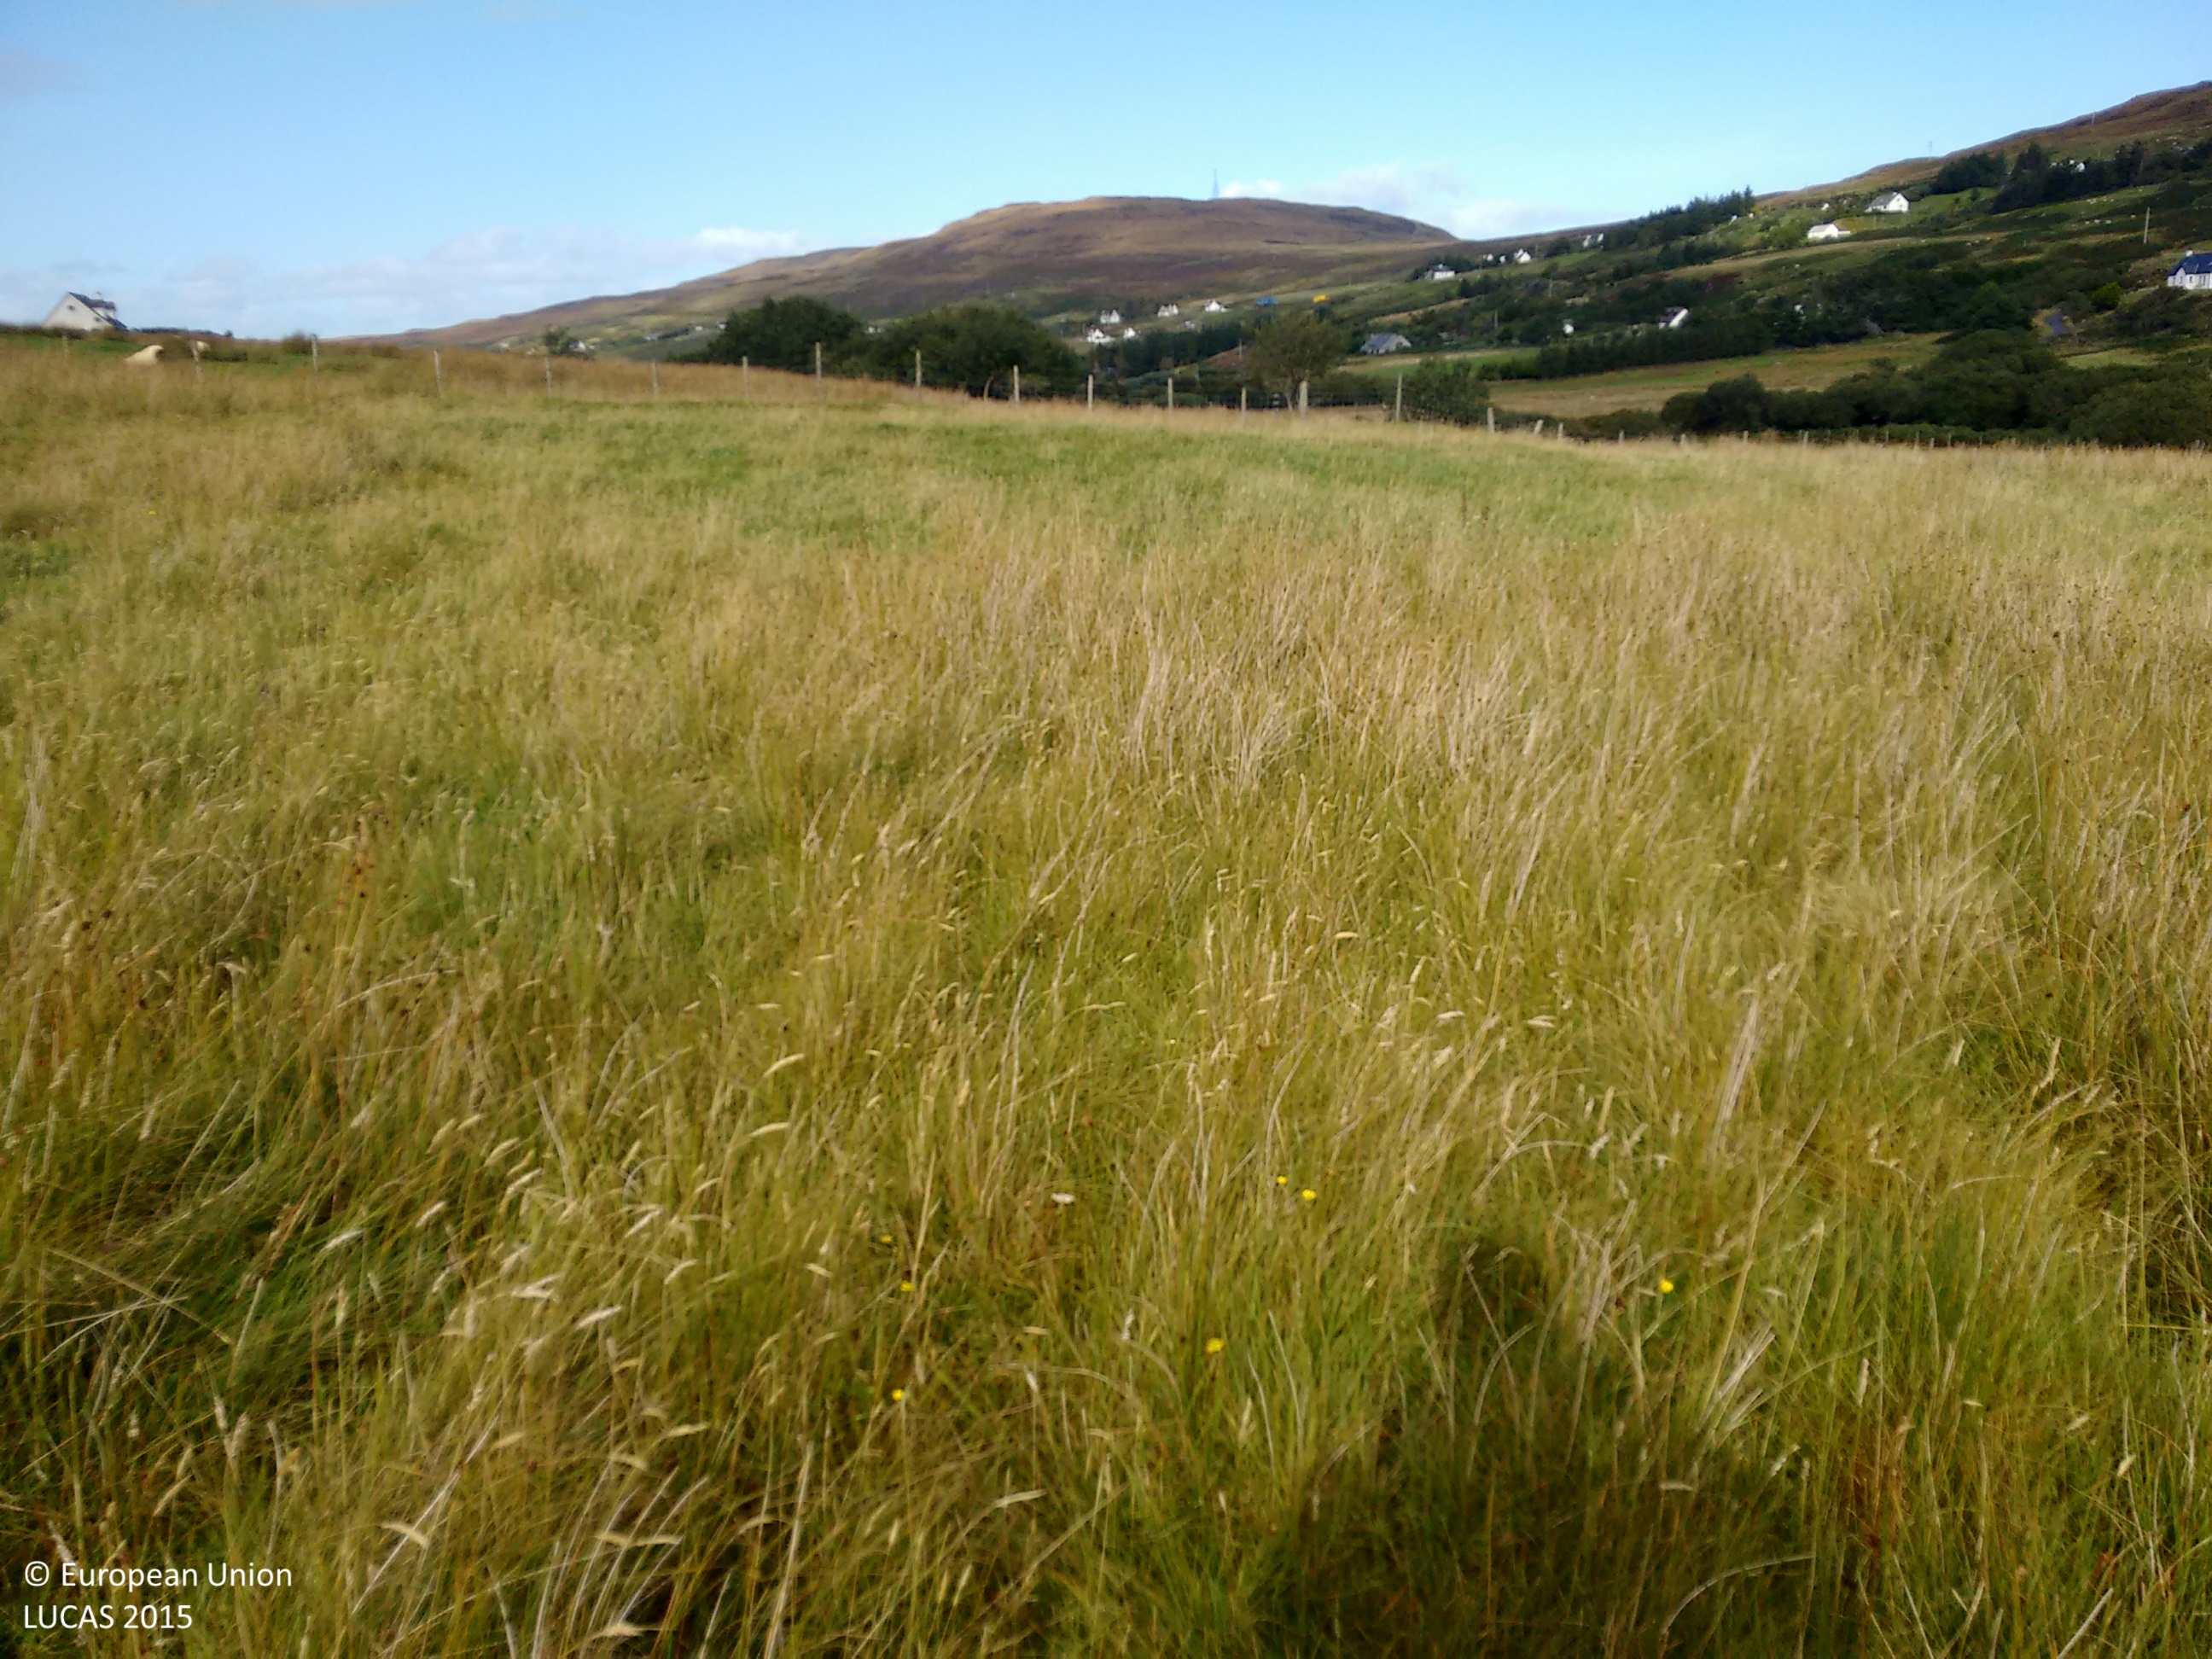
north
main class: Grassland
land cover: Grassland without tree/shrub cover
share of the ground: > 75 %
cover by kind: herbaceous plants 100 %
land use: Agriculture (excluding fallow land and kitchen gardens)
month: September
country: GB
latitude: 57.4404
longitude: -6.6921
